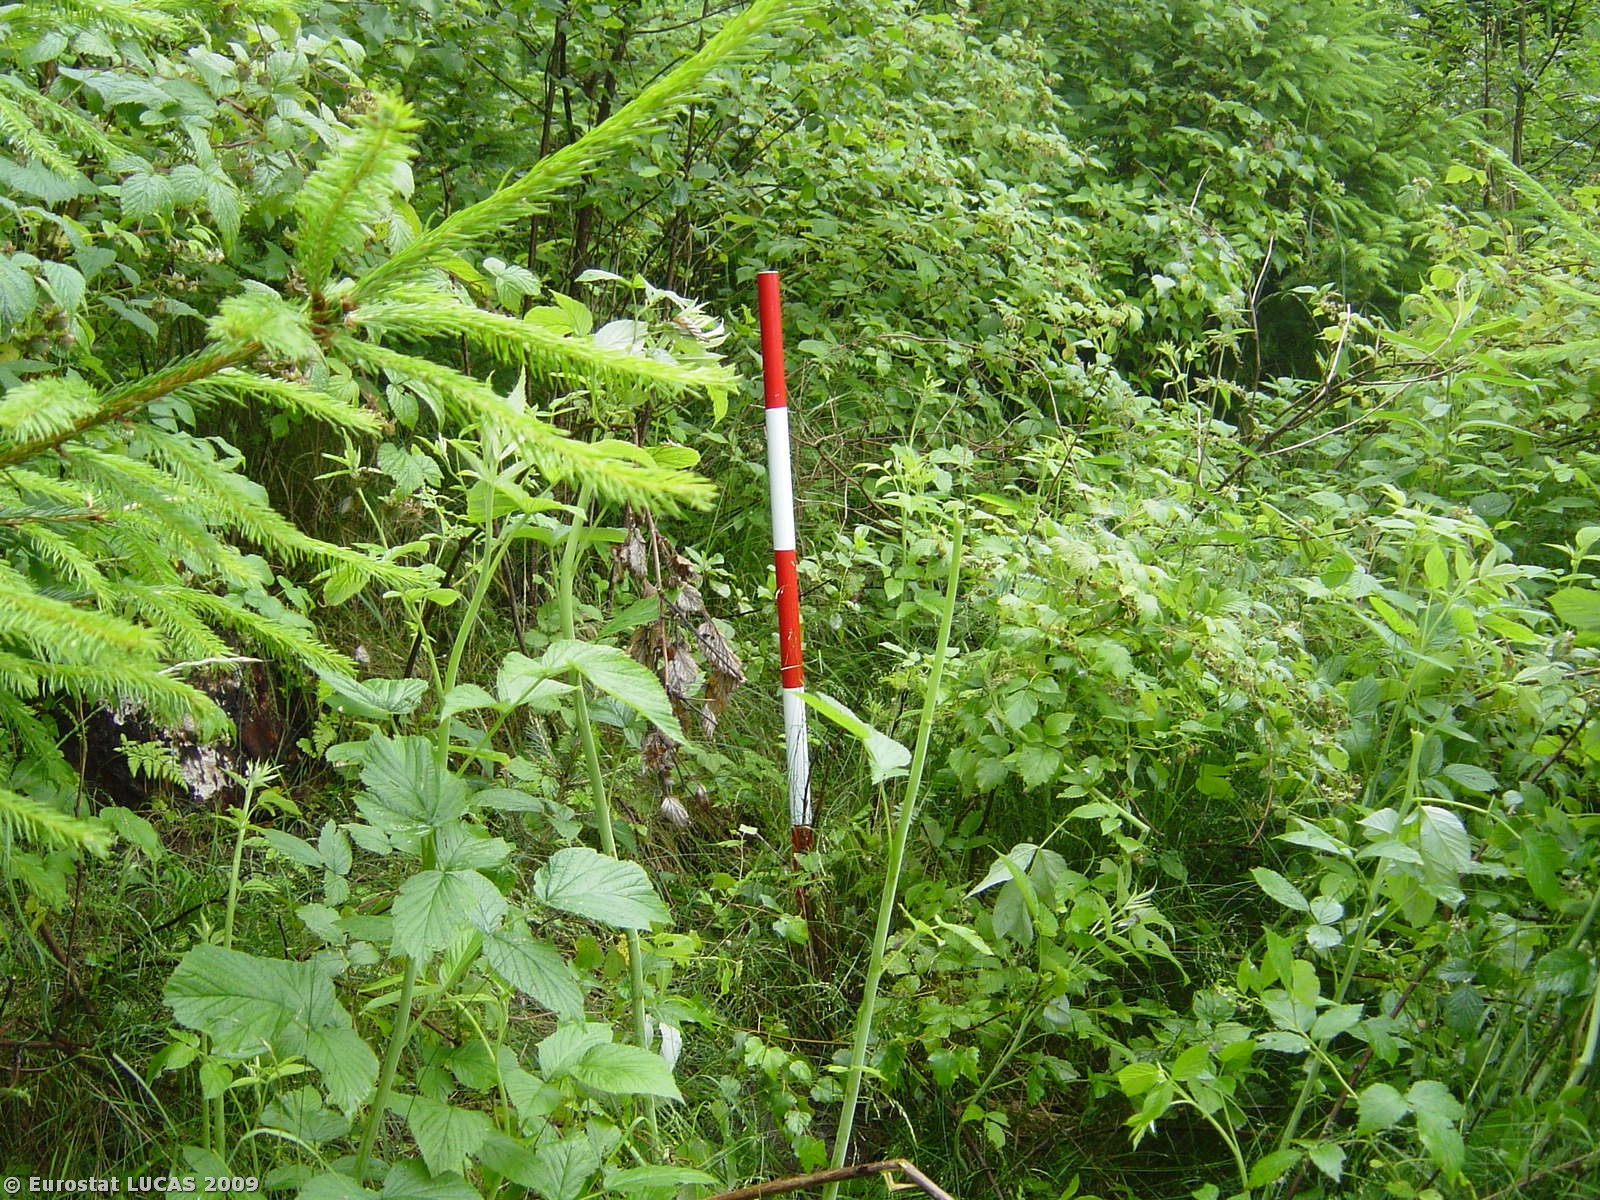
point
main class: Woodland
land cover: Mixed woodland
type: hemiboreal forest and nemoral coniferous forest and mixed broadleaved-coniferous forest
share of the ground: > 75 %
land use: Forestry
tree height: > 5 m
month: June
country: CZ
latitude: 49.6557
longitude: 16.5040
